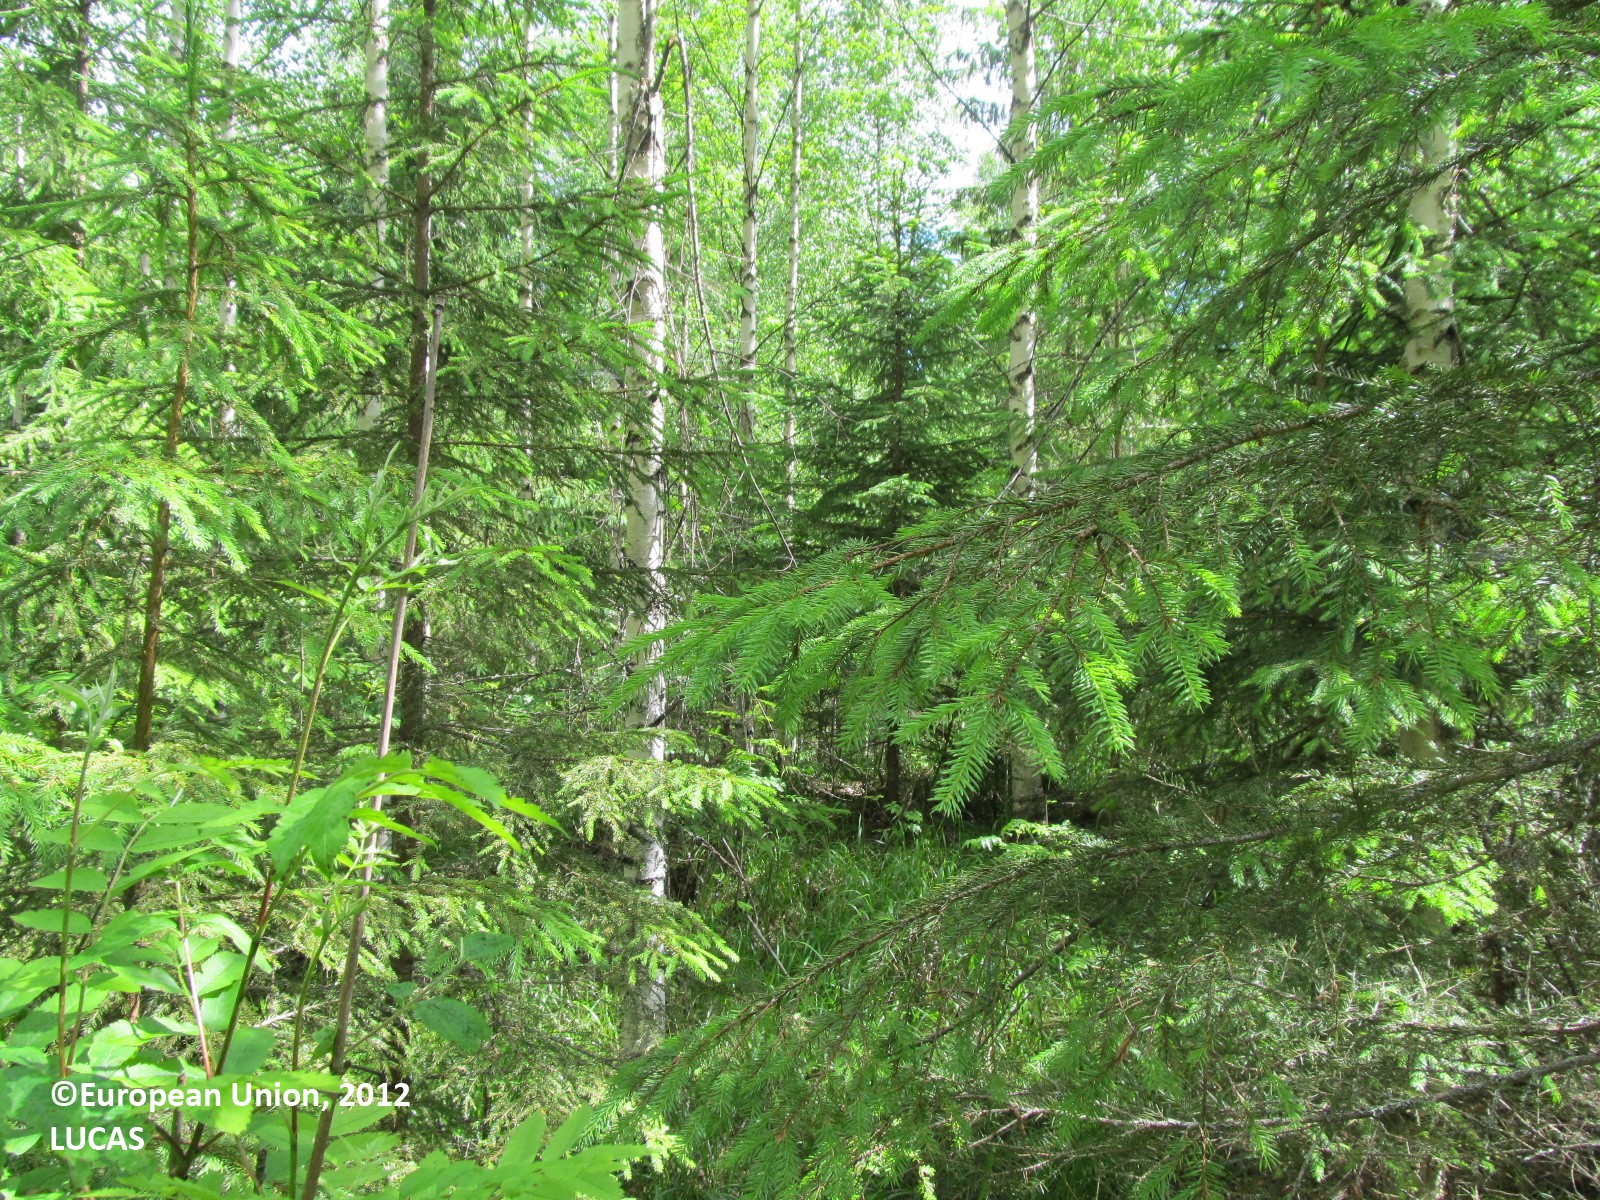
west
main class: Woodland
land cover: Spruce dominated mixed woodland
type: boreal forest
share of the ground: > 75 %
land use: Forestry
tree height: > 5 m
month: June
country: FI
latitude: 62.6658
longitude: 28.8954
